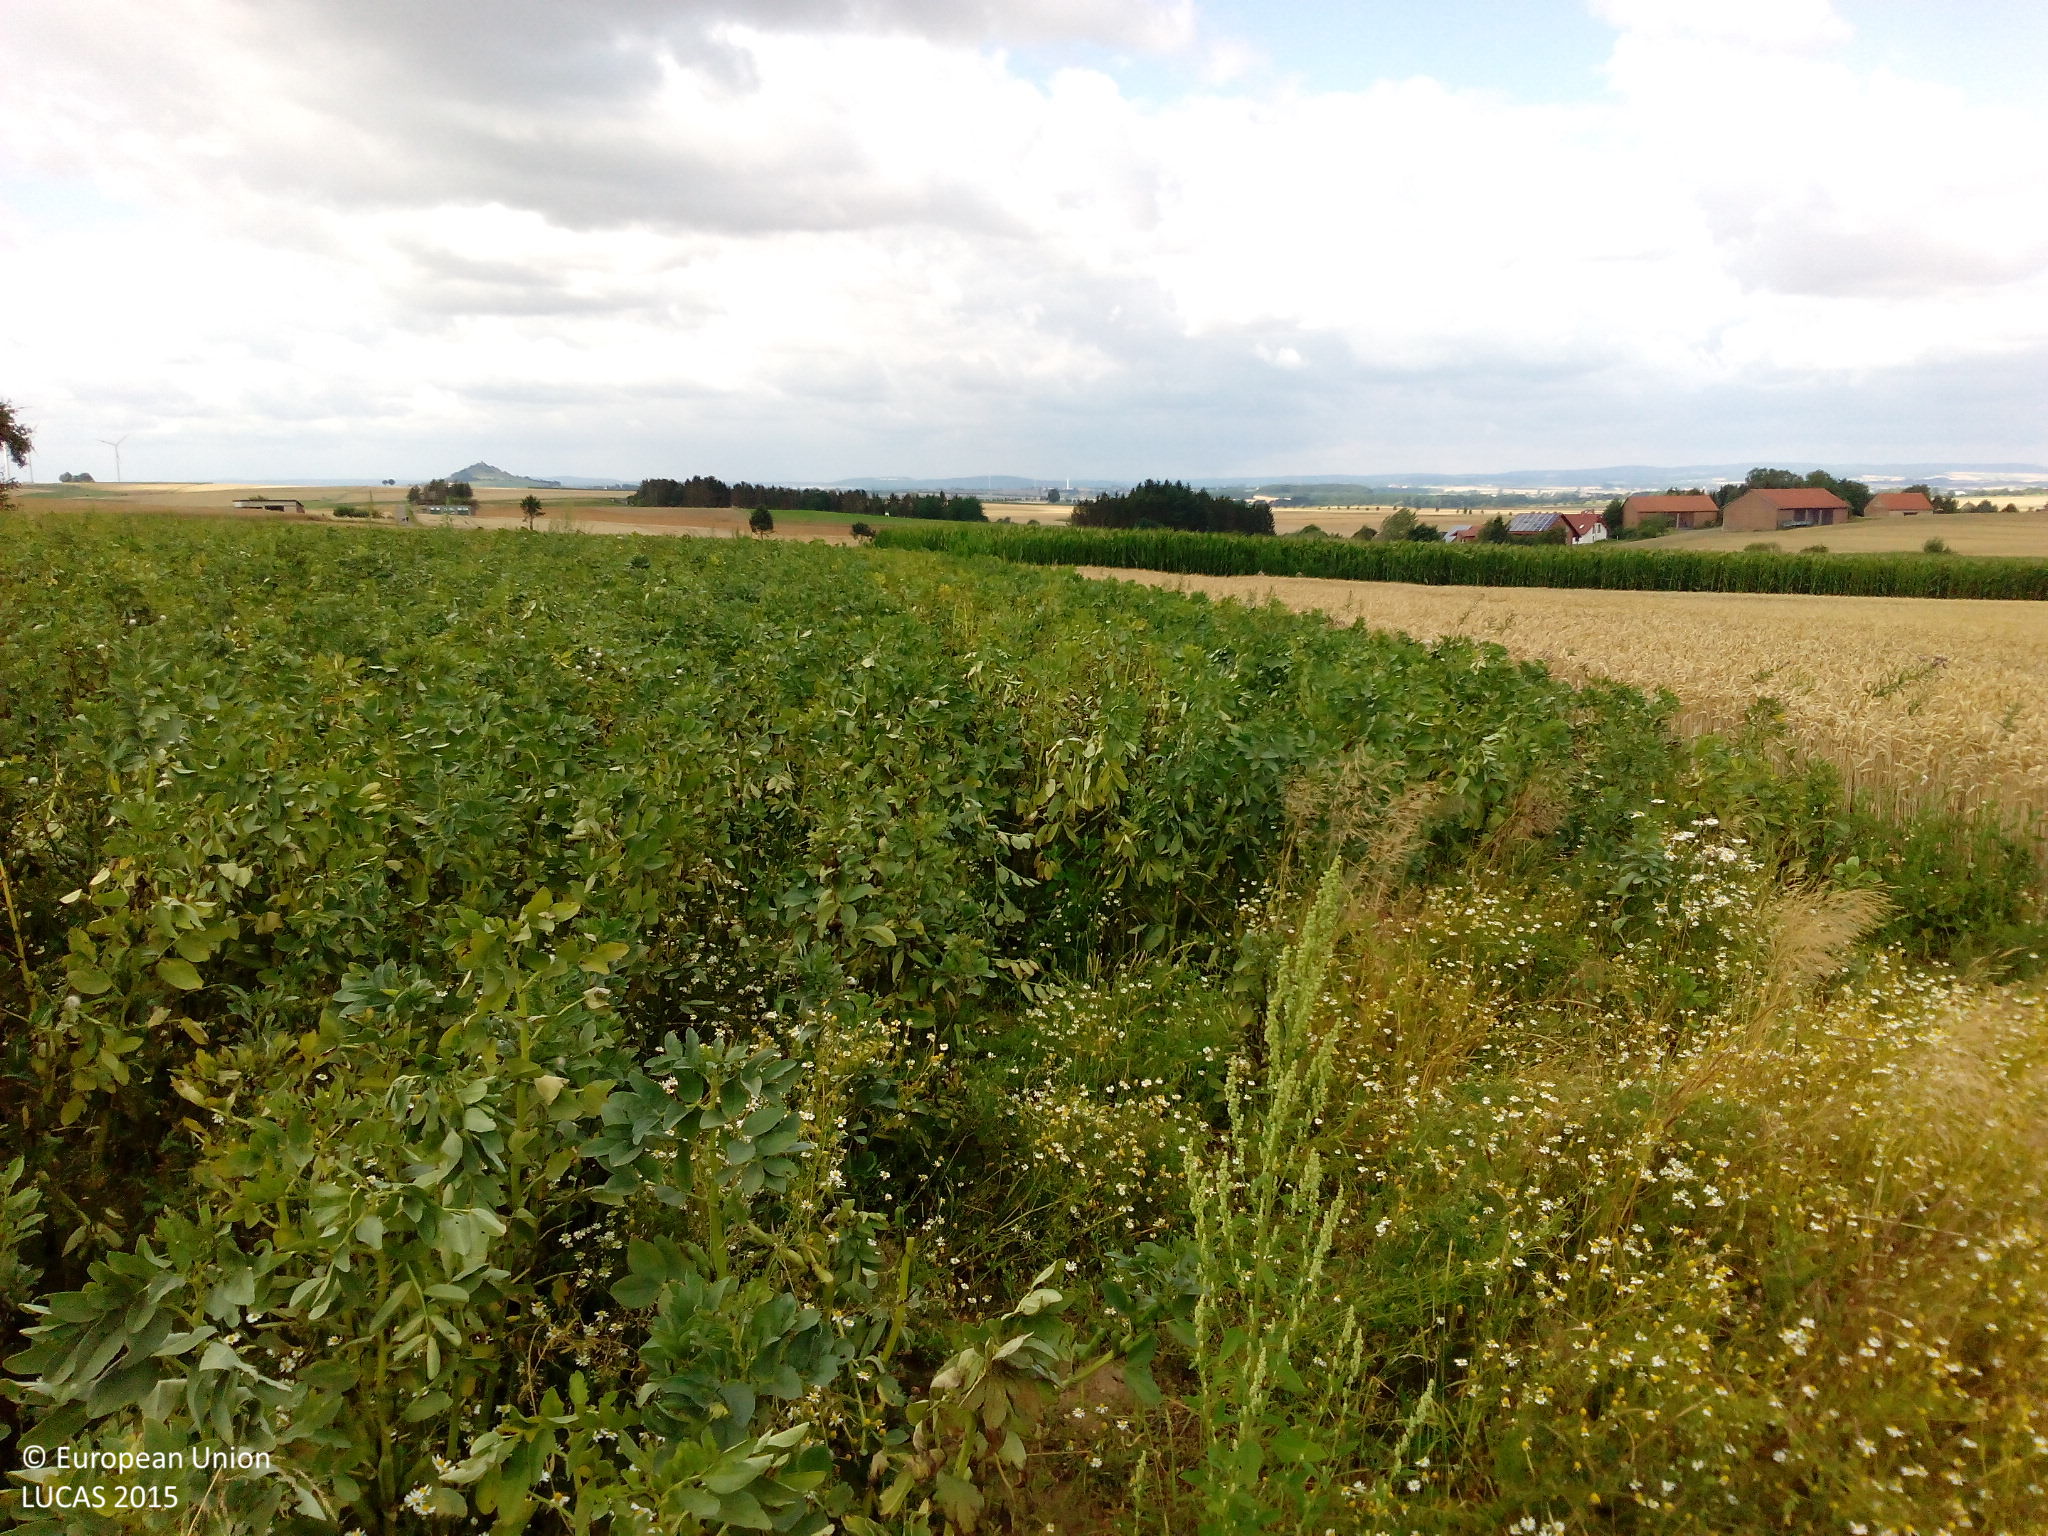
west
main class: Cropland
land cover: Dry pulses
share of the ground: > 75 %
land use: Agriculture (excluding fallow land and kitchen gardens)
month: July
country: DE
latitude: 51.5305
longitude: 9.2939
